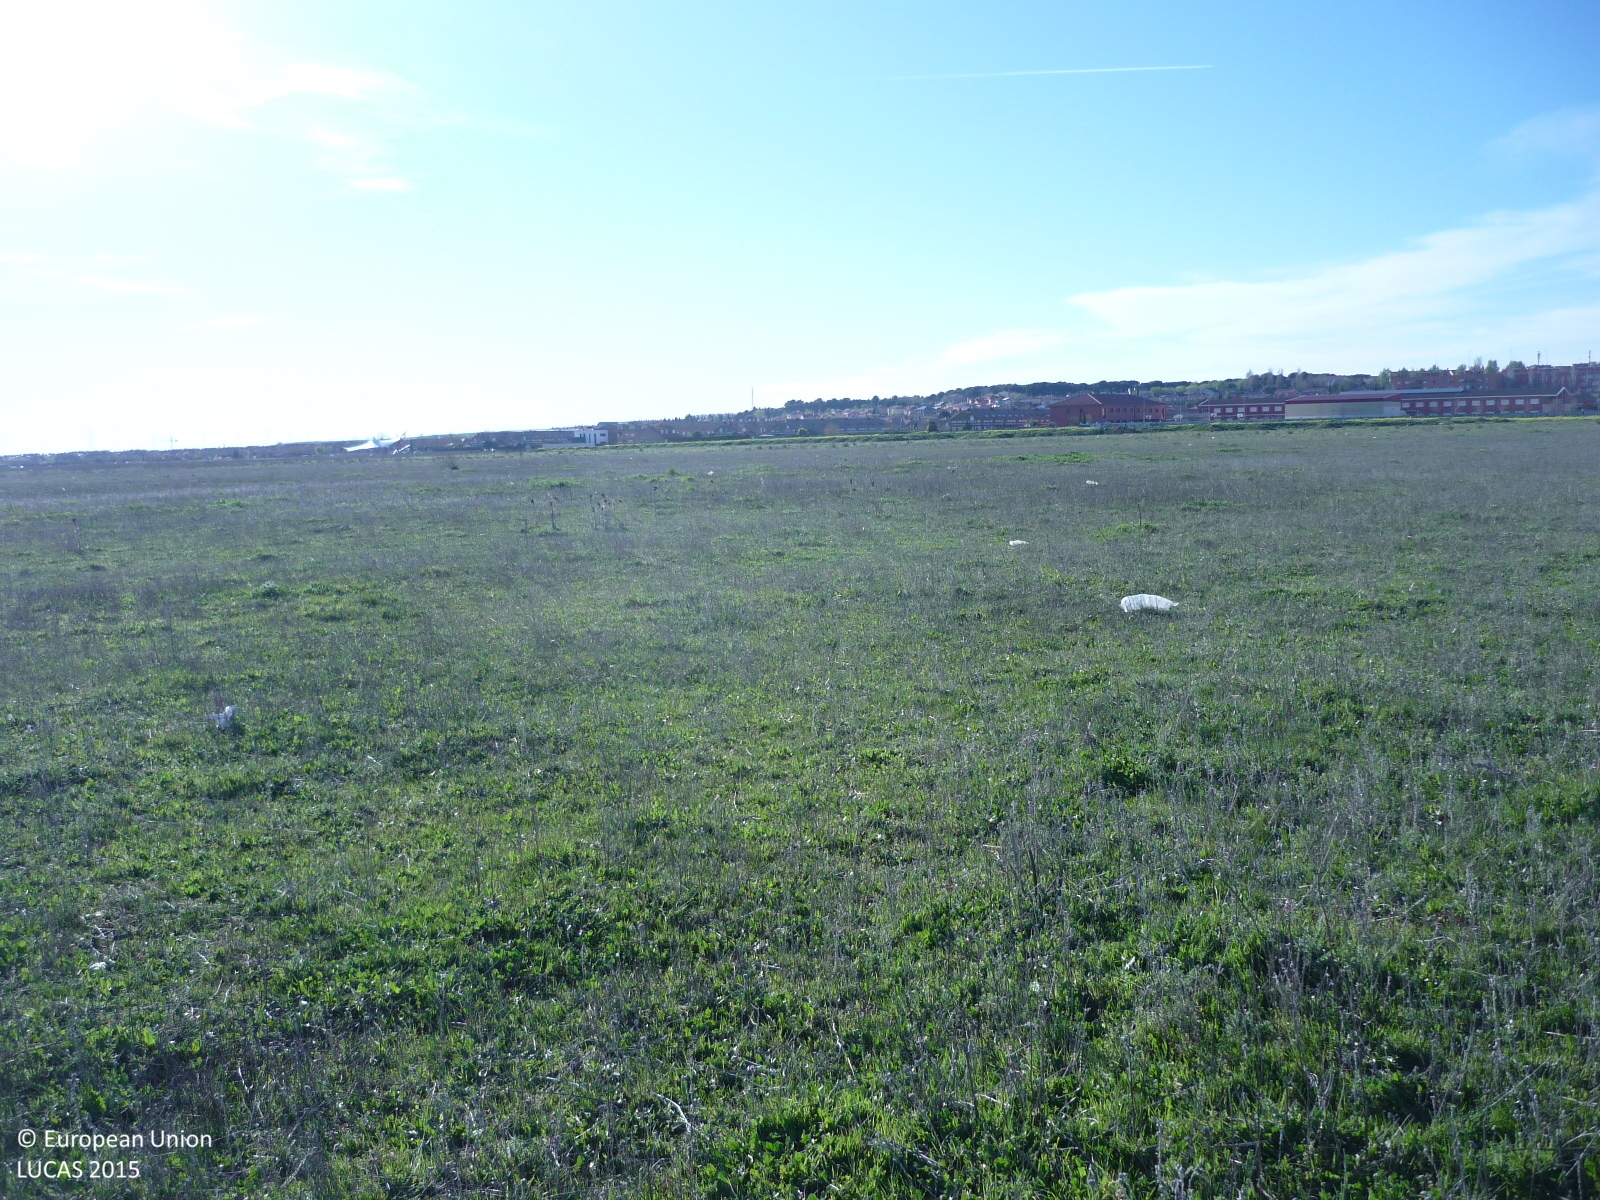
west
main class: Grassland
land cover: Grassland without tree/shrub cover
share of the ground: > 75 %
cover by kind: herbaceous plants 100 %
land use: Semi-natural and natural areas not in use
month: March
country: ES
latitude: 40.5448
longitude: -3.3178
